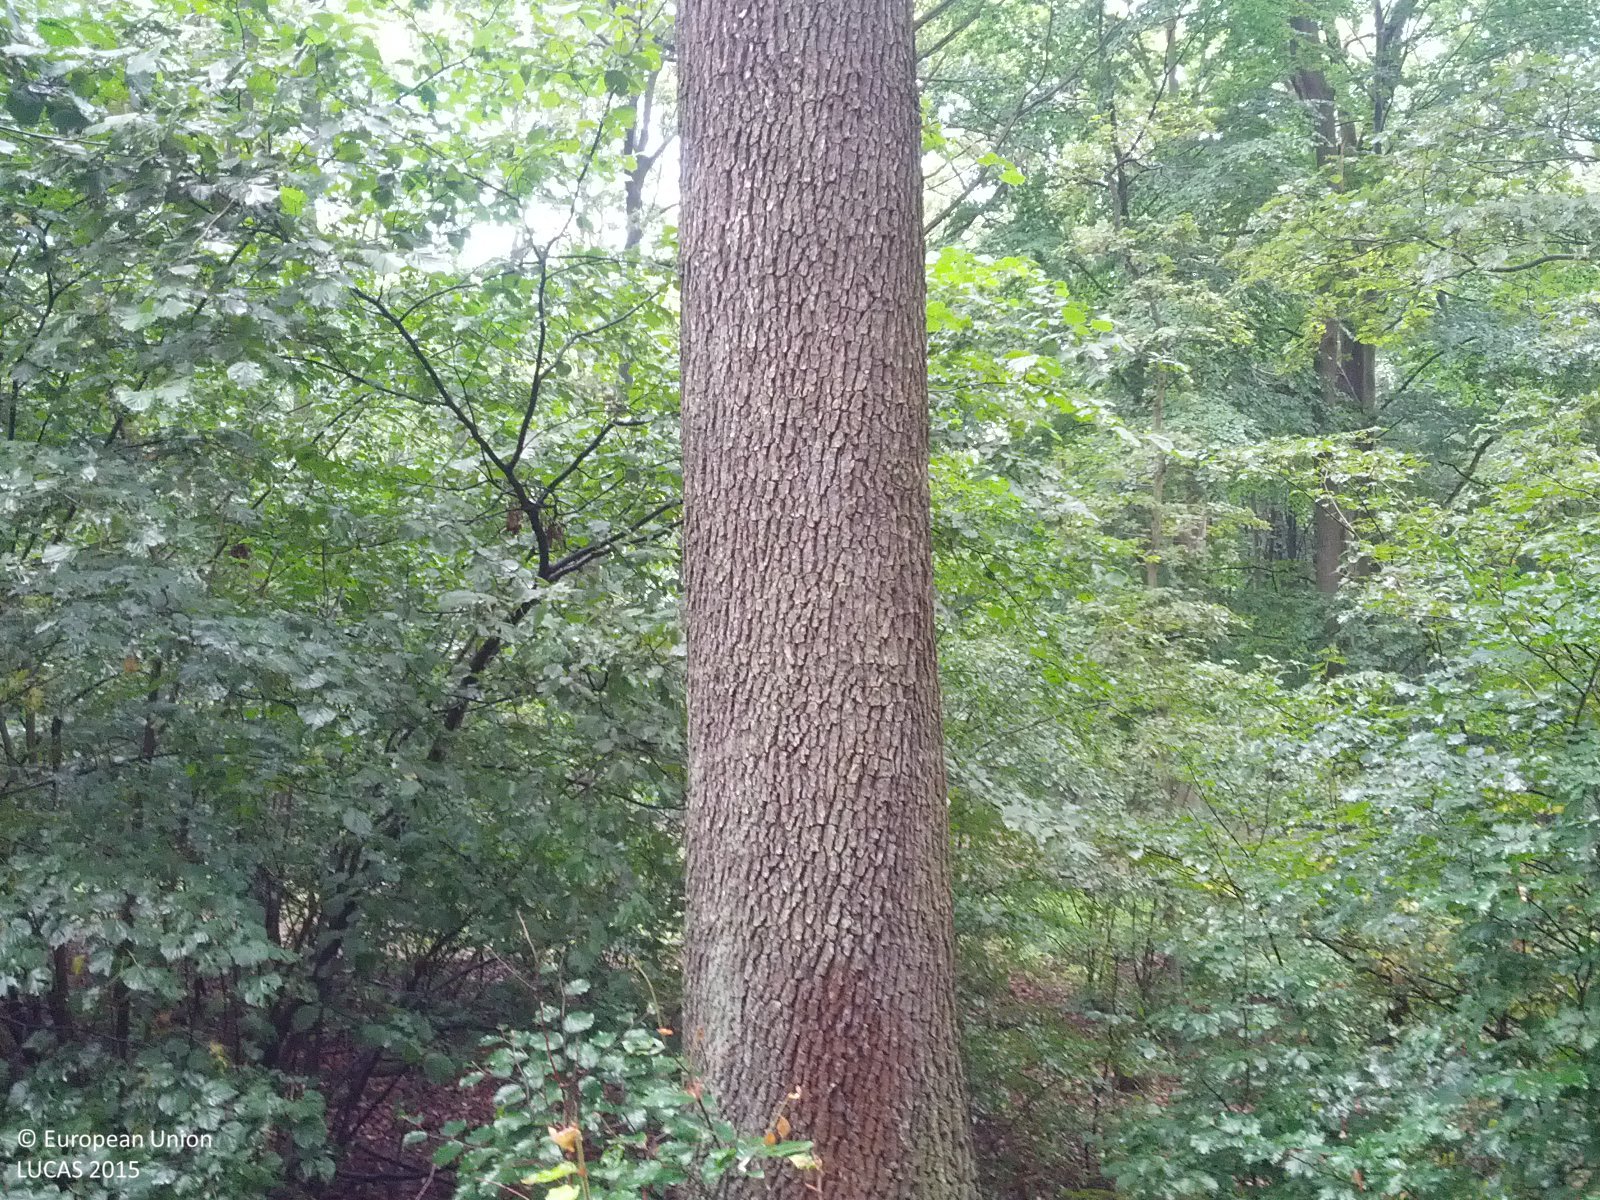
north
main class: Woodland
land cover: Broadleaved woodland
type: acidophilous oak and oak-birch forest
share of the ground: > 75 %
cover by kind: broadleaved forest trees 80 %, shrubs 10 %, herbaceous plants 10 %
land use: Forestry
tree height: > 5 m
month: July
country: AT
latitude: 48.5469
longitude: 16.3315
